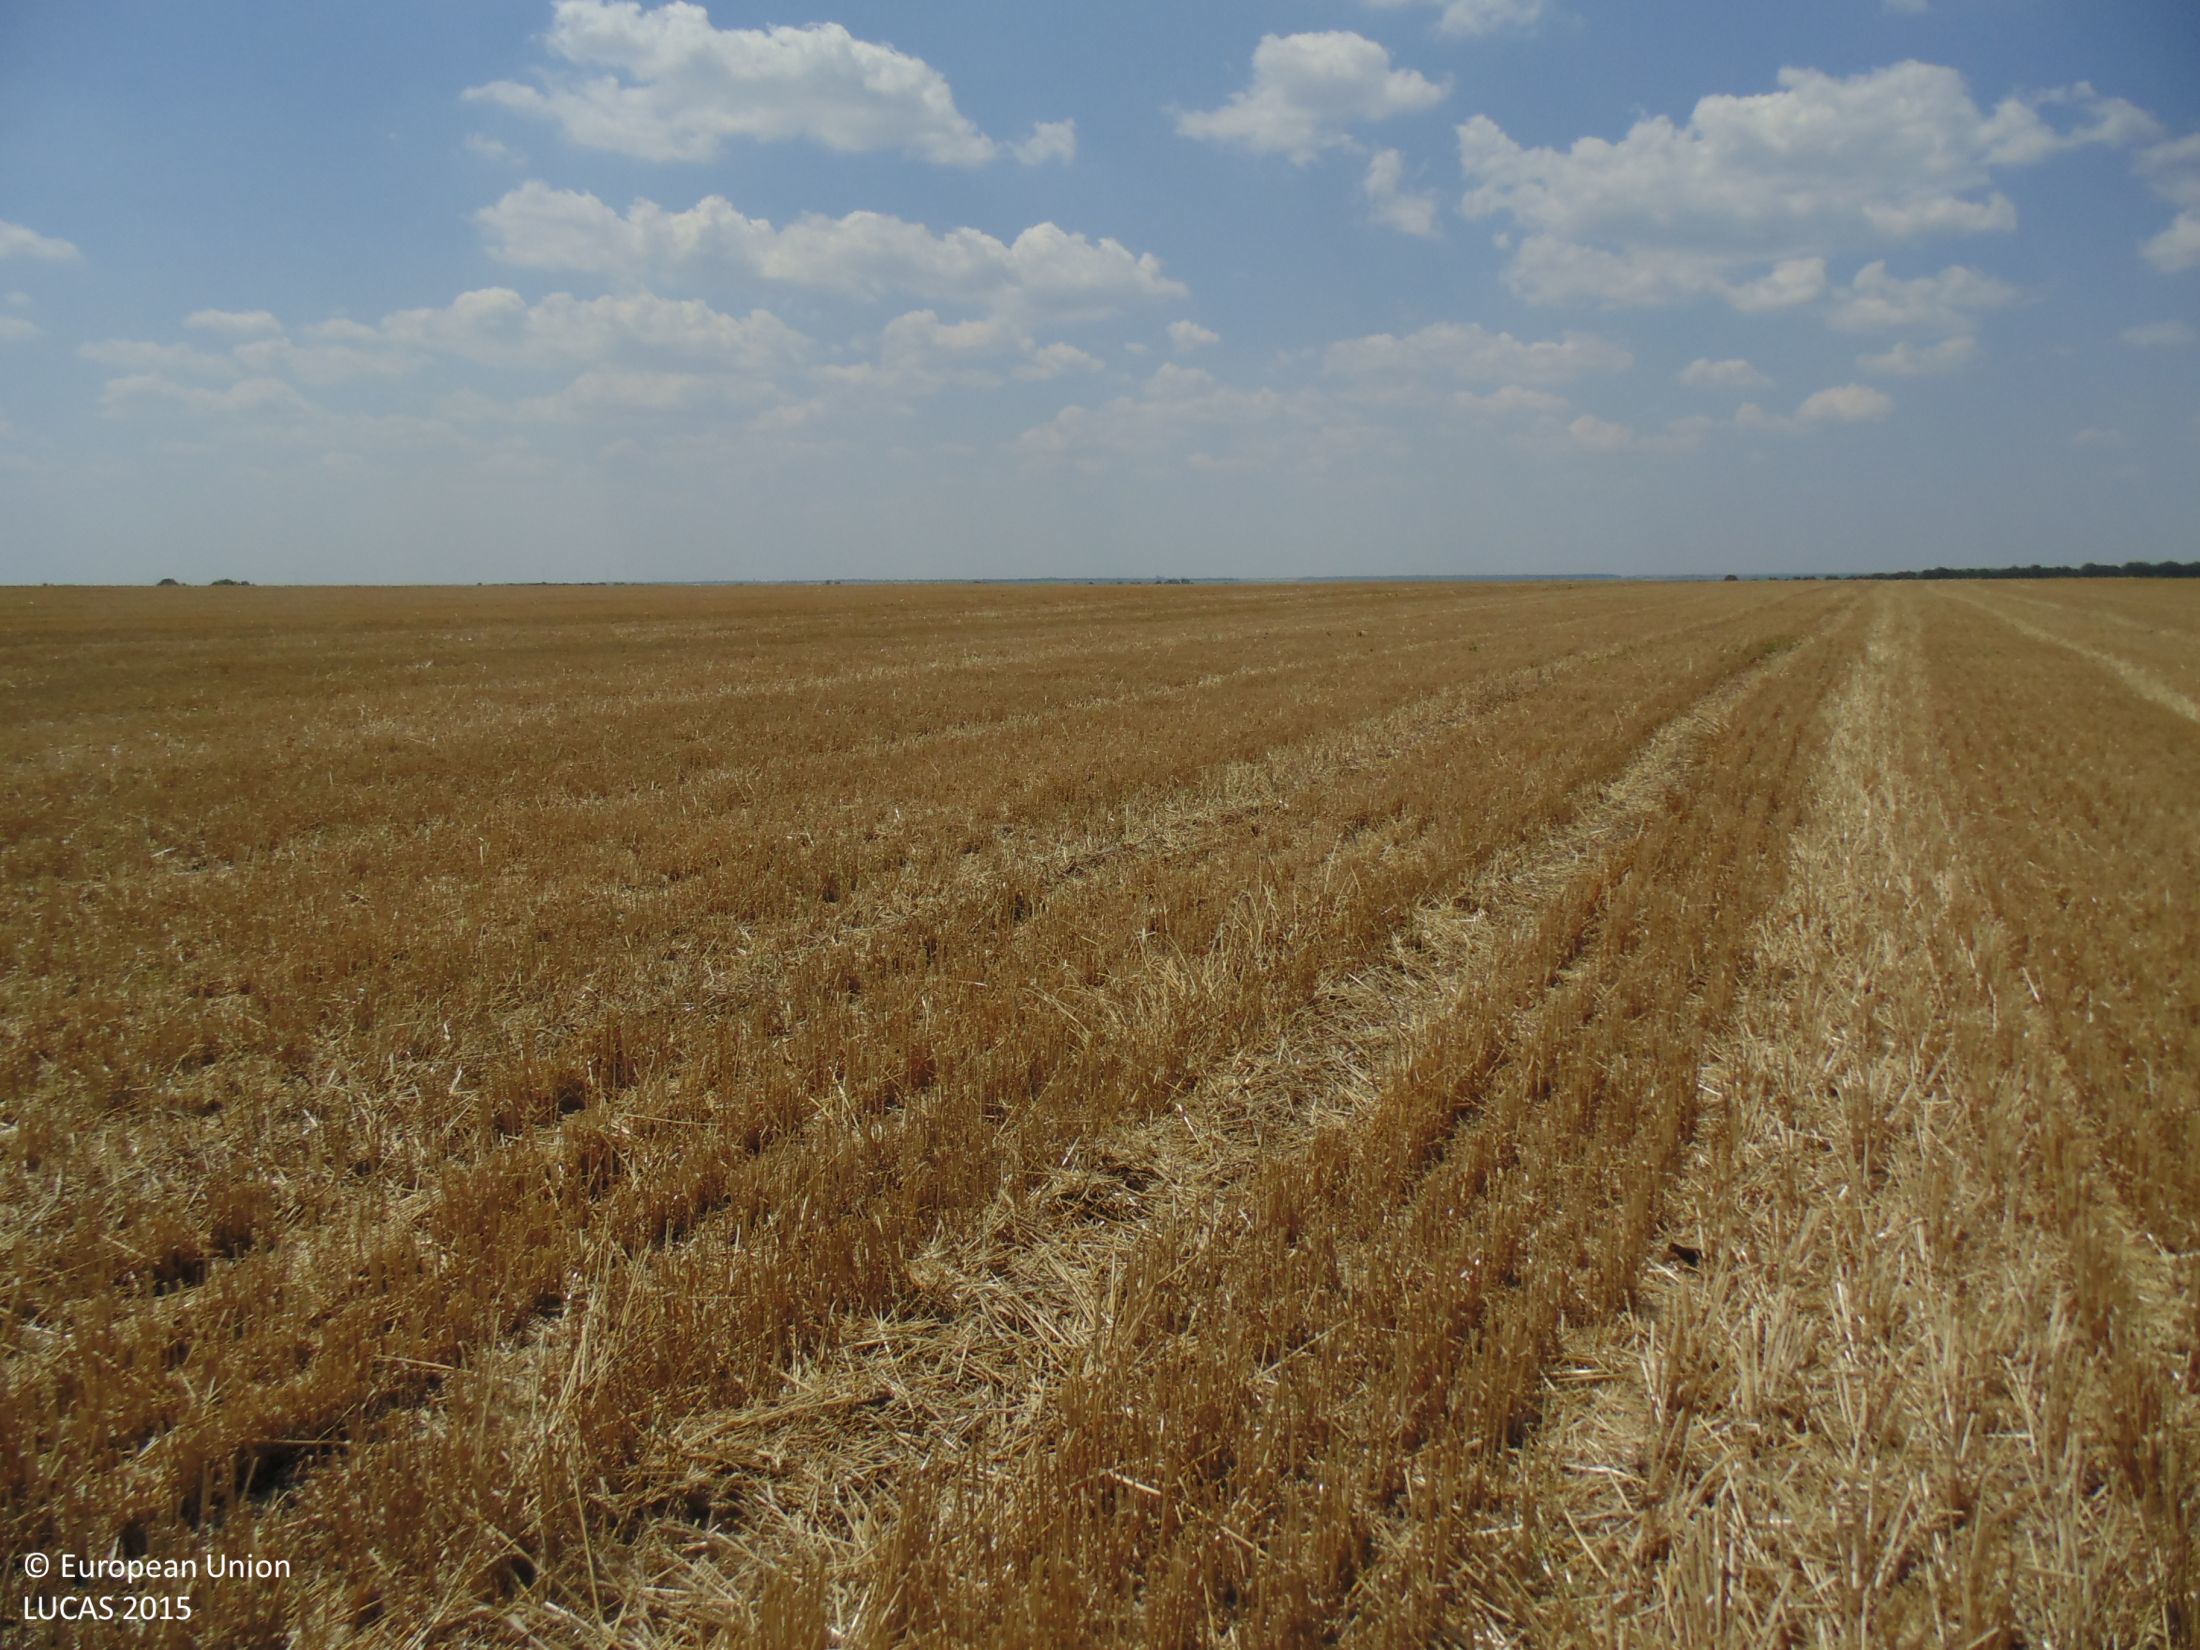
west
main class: Cropland
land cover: Common wheat
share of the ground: > 75 %
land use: Agriculture (excluding fallow land and kitchen gardens)
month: July
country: BG
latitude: 43.6861
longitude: 27.6673
